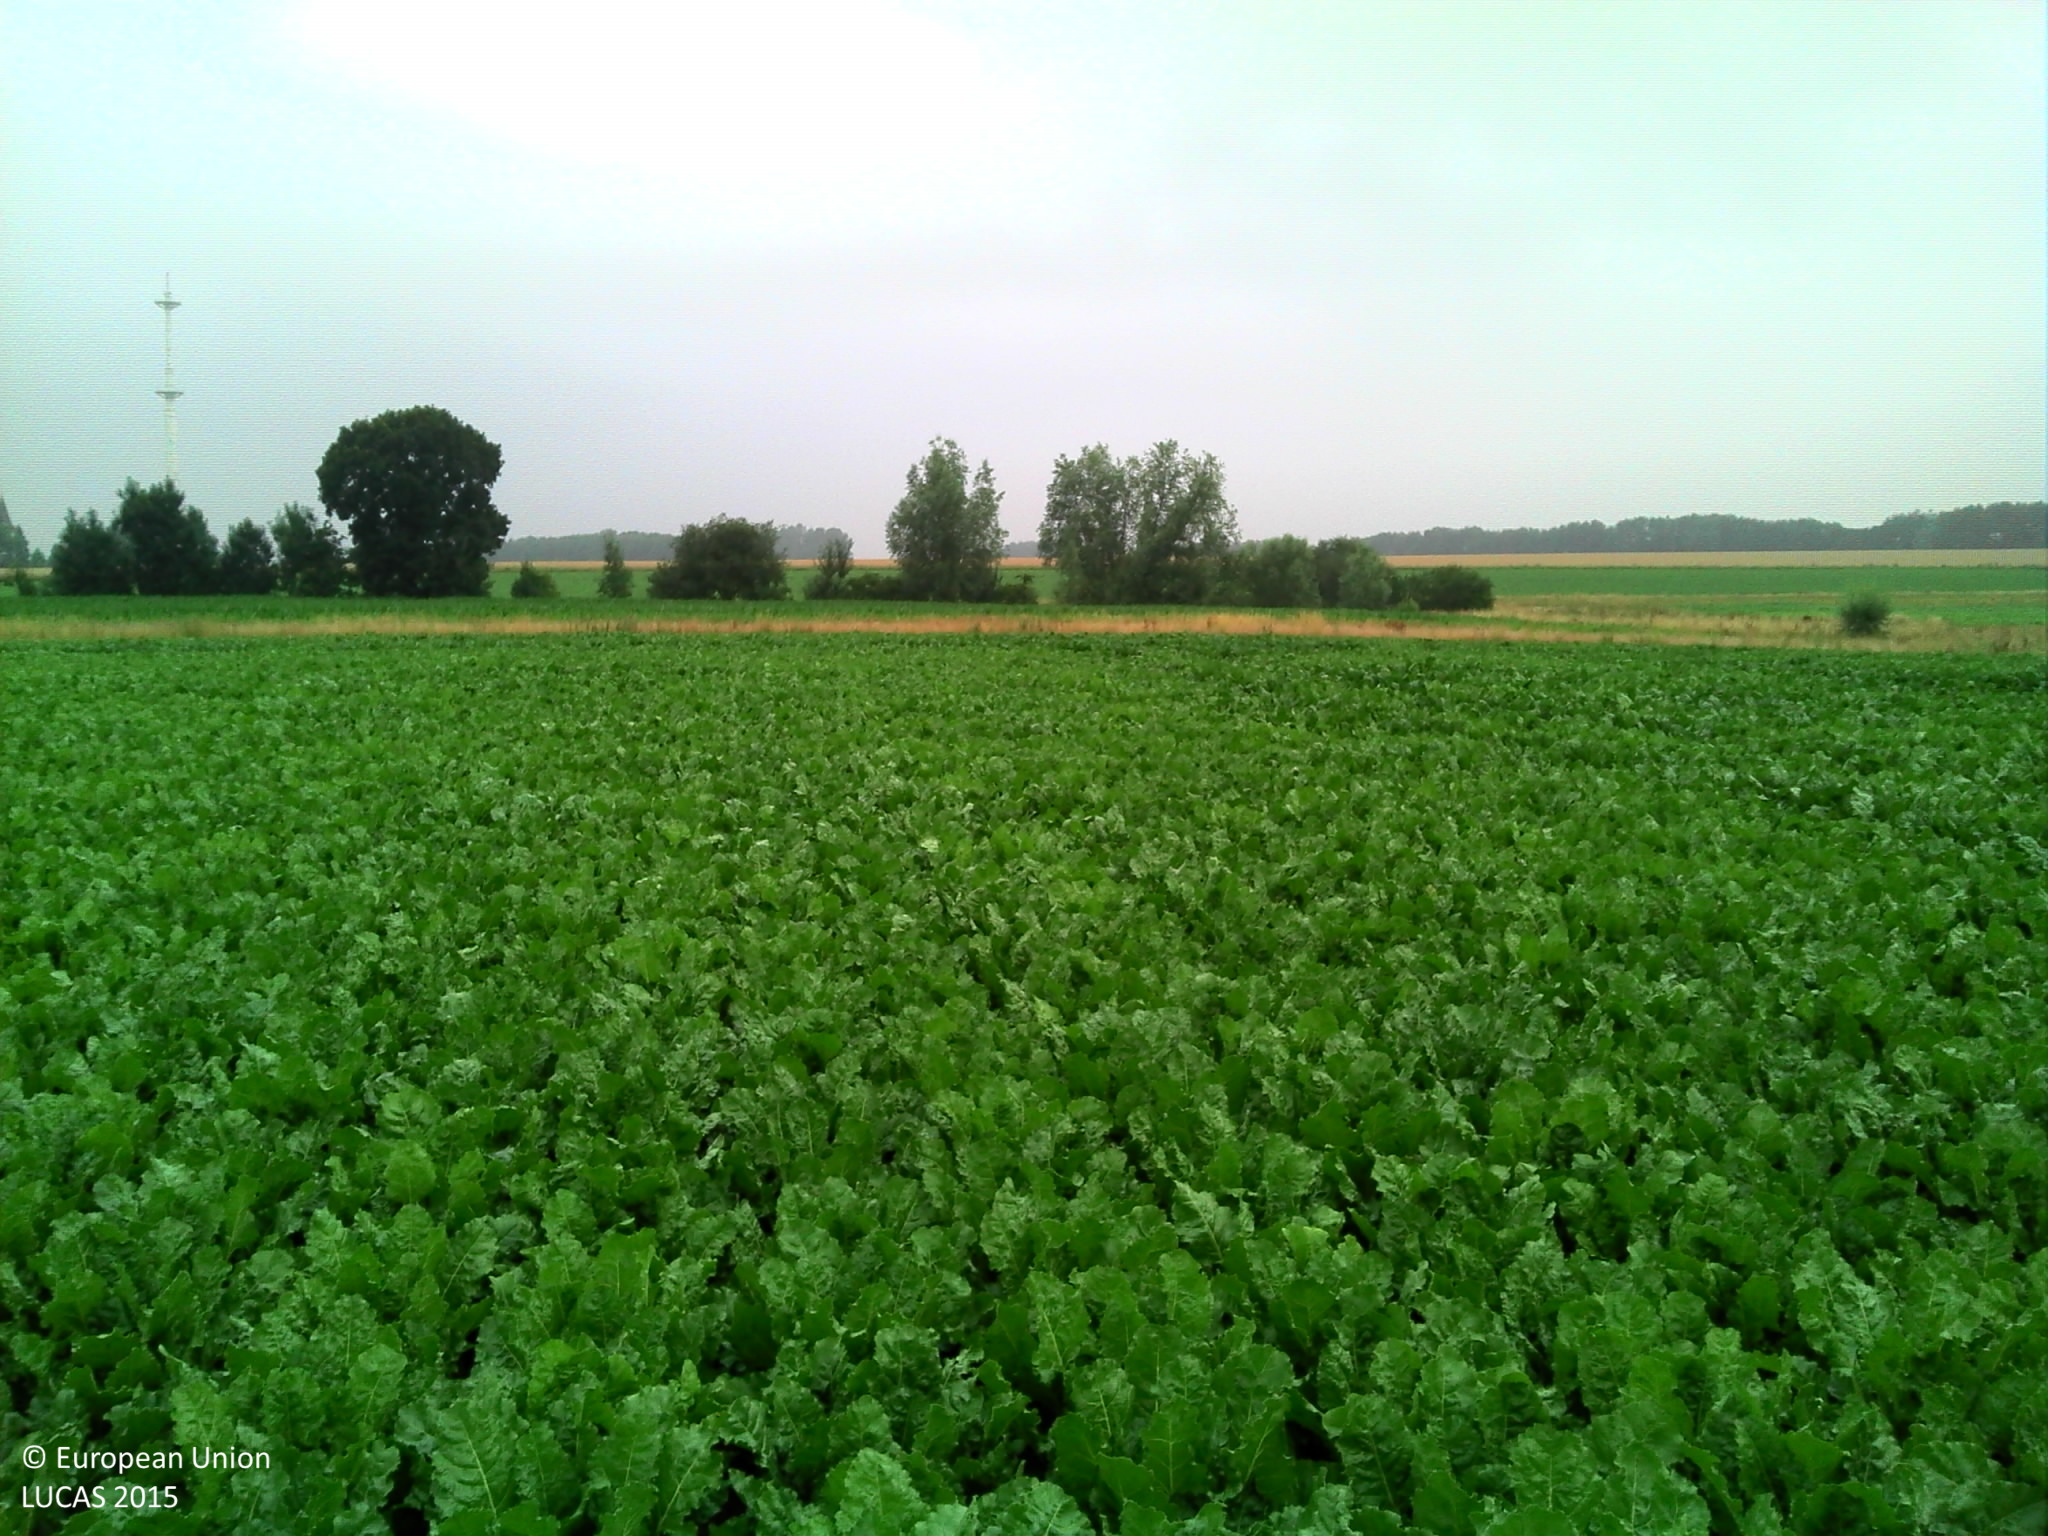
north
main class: Cropland
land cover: Sugar beet
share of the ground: > 75 %
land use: Agriculture (excluding fallow land and kitchen gardens)
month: July
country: BE
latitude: 50.3534
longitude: 4.0493
